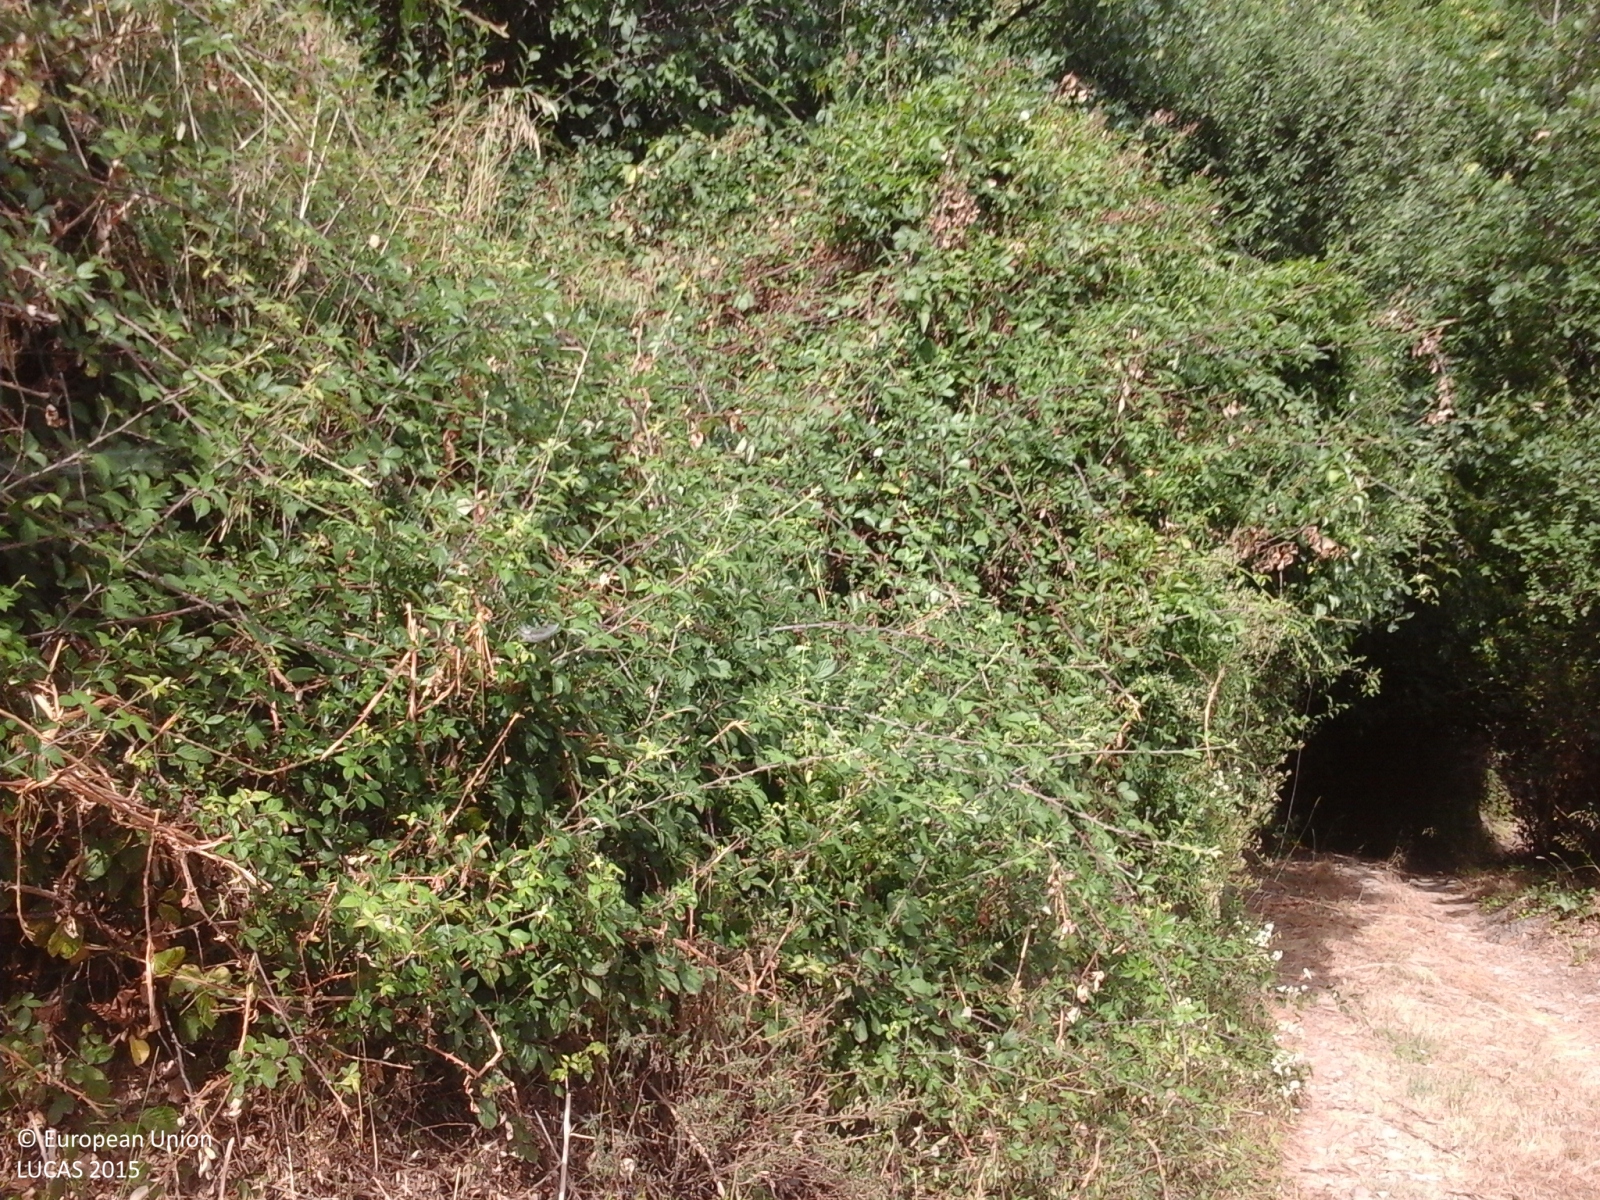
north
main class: Woodland
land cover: Broadleaved woodland
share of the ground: > 75 %
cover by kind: broadleaved forest trees 100 %
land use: Forestry
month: August
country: IT
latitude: 43.1922
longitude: 10.8465
